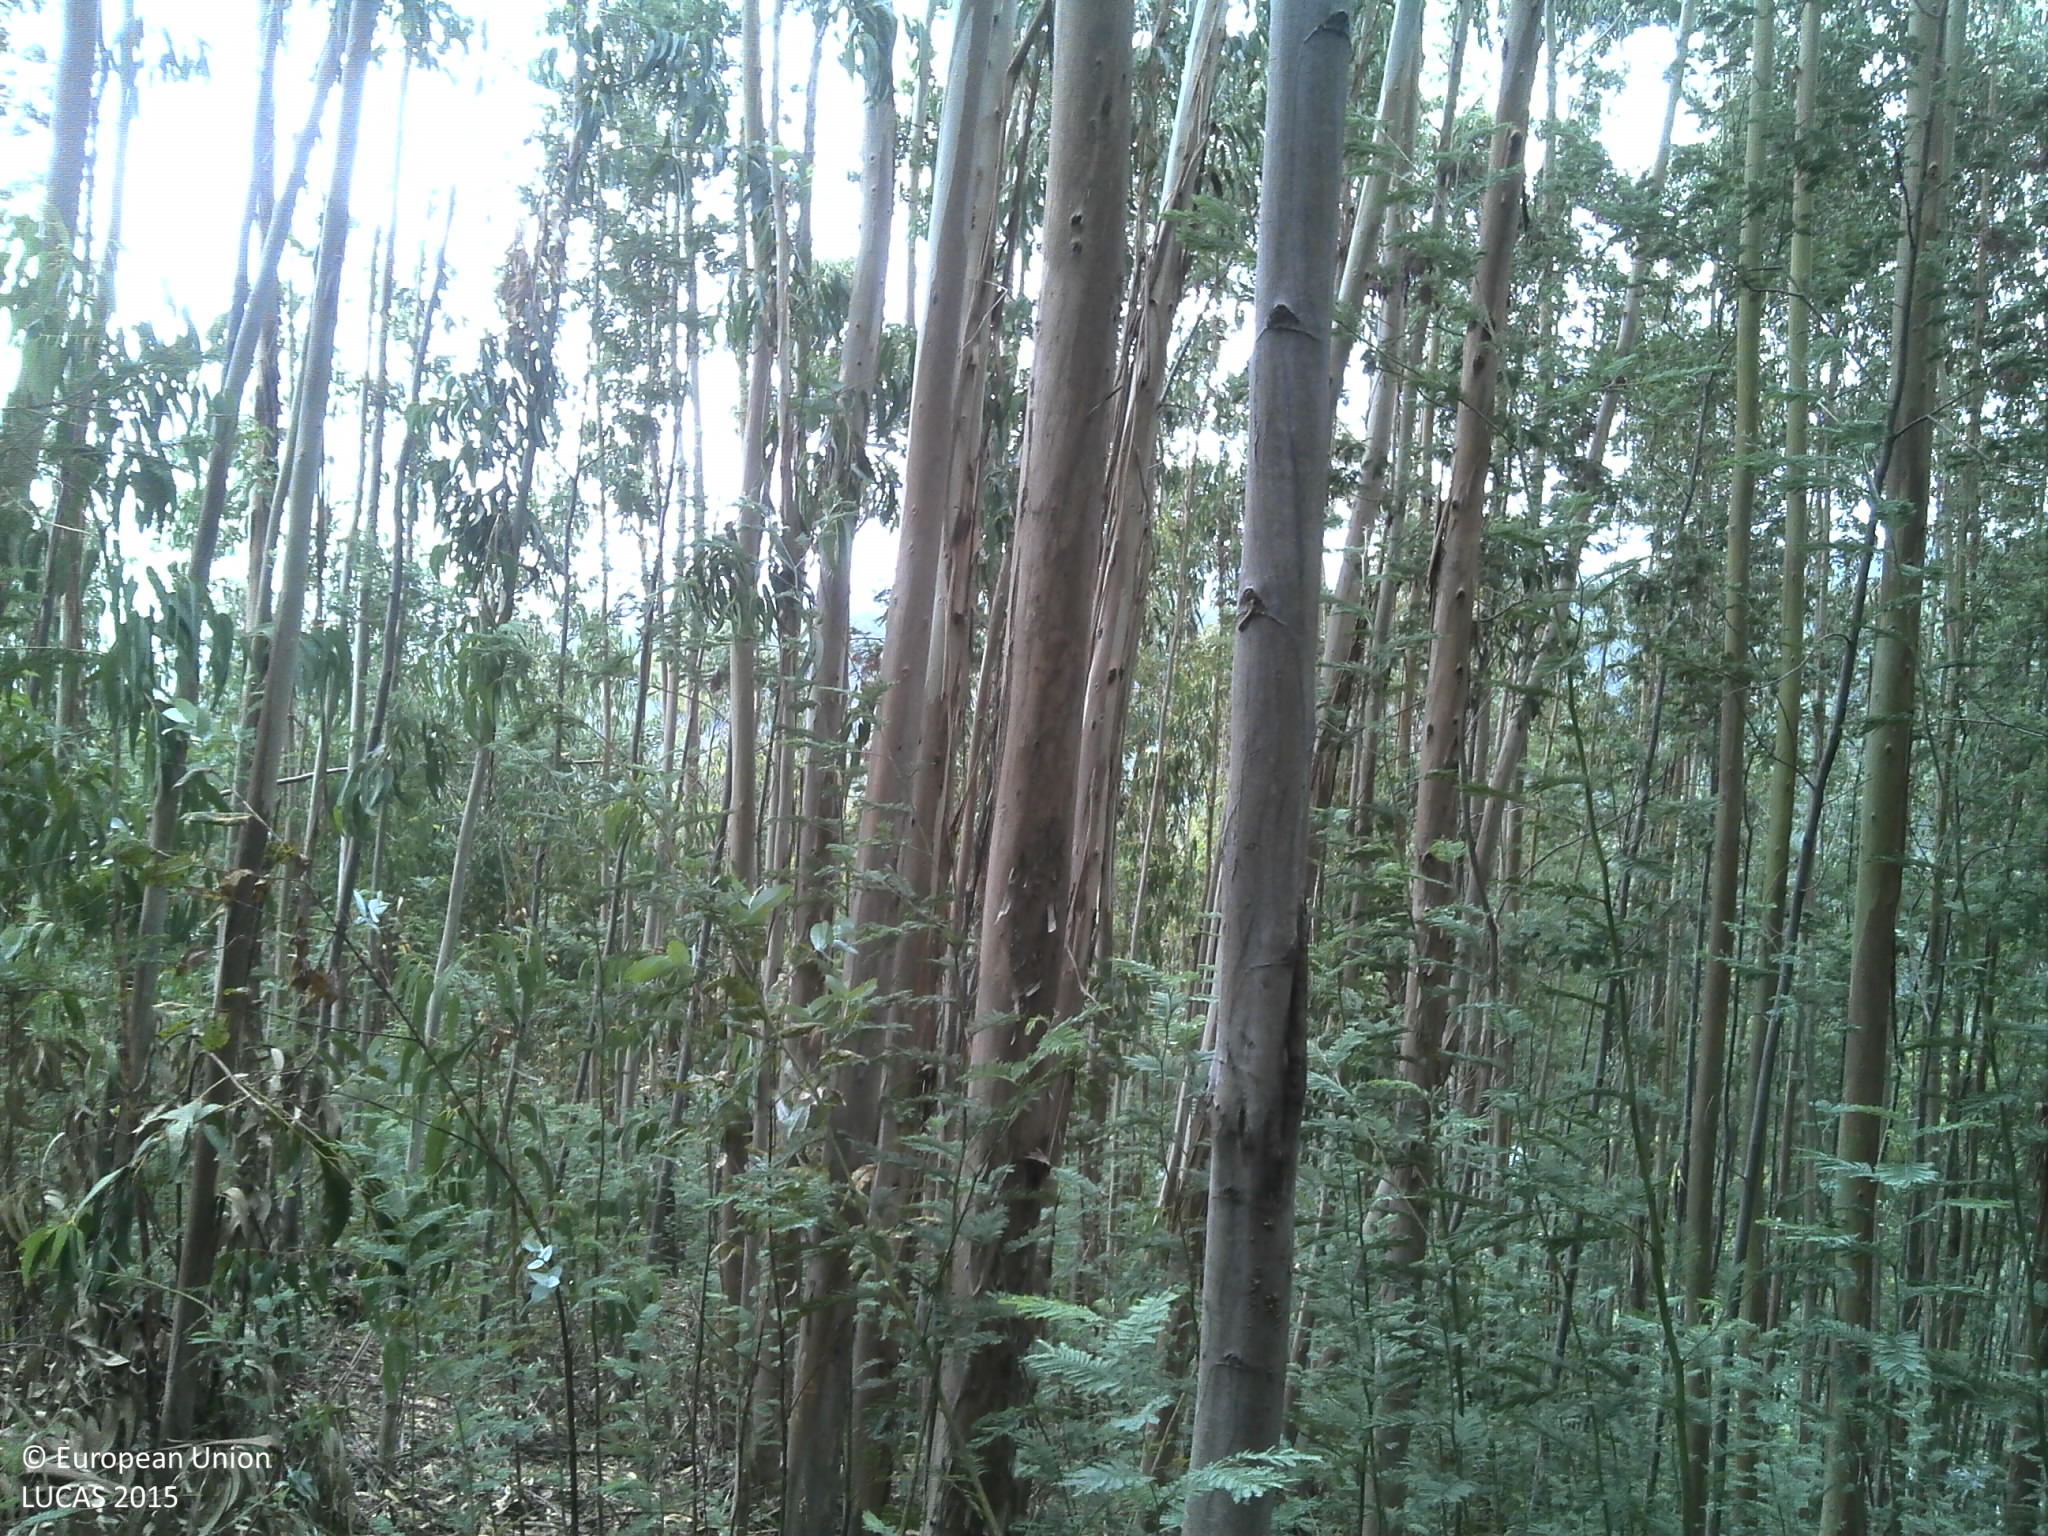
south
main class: Woodland
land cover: Broadleaved woodland
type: exotic forest
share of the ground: 50 - 75 %
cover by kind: broadleaved forest trees 60 %, unconsolidated bare surface 25 %, shrubs 15 %
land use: Forestry
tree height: > 5 m
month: July
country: PT
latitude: 40.2683
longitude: -8.2963
